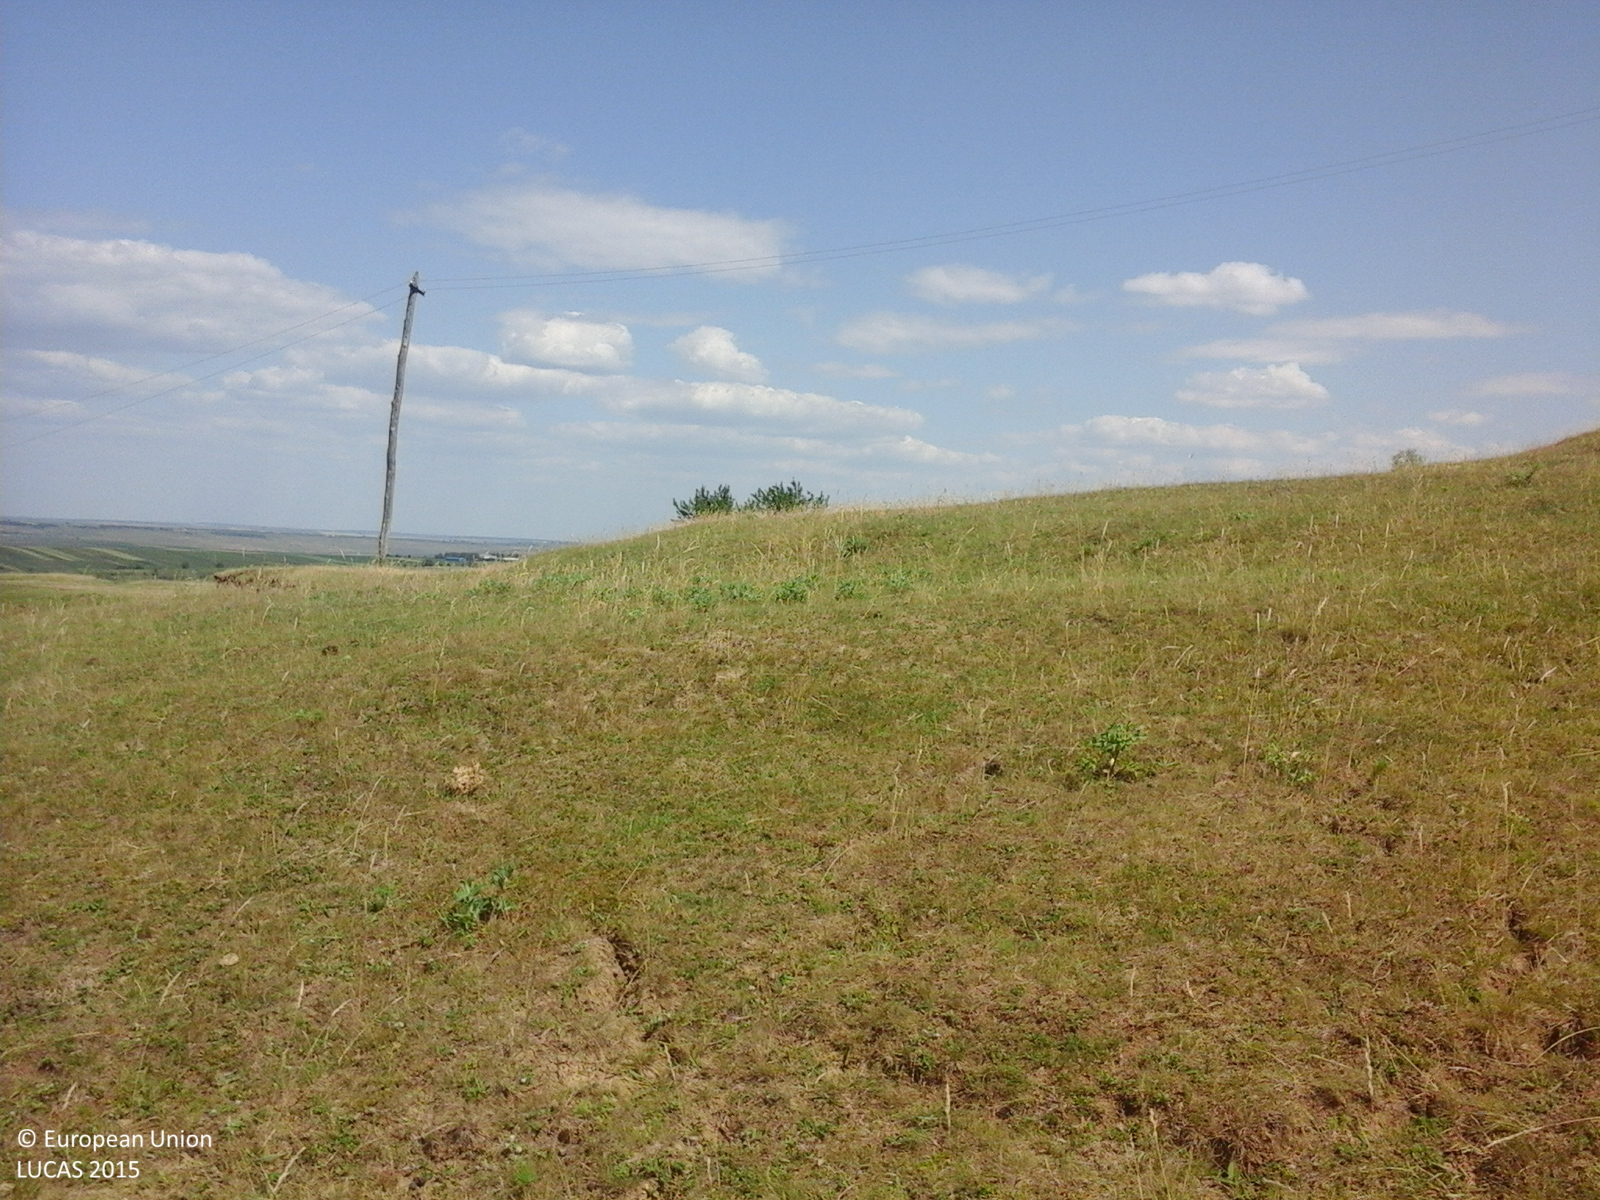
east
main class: Grassland
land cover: Grassland without tree/shrub cover
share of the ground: > 75 %
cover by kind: herbaceous plants 100 %
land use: Agriculture (excluding fallow land and kitchen gardens)
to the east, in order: Grassland without tree/shrub cover; Tracks; Grassland without tree/shrub cover; Electric lines; Grassland without tree/shrub cover; Tracks; Grassland without tree/shrub cover
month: June
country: RO
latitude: 47.7955
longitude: 26.4980
